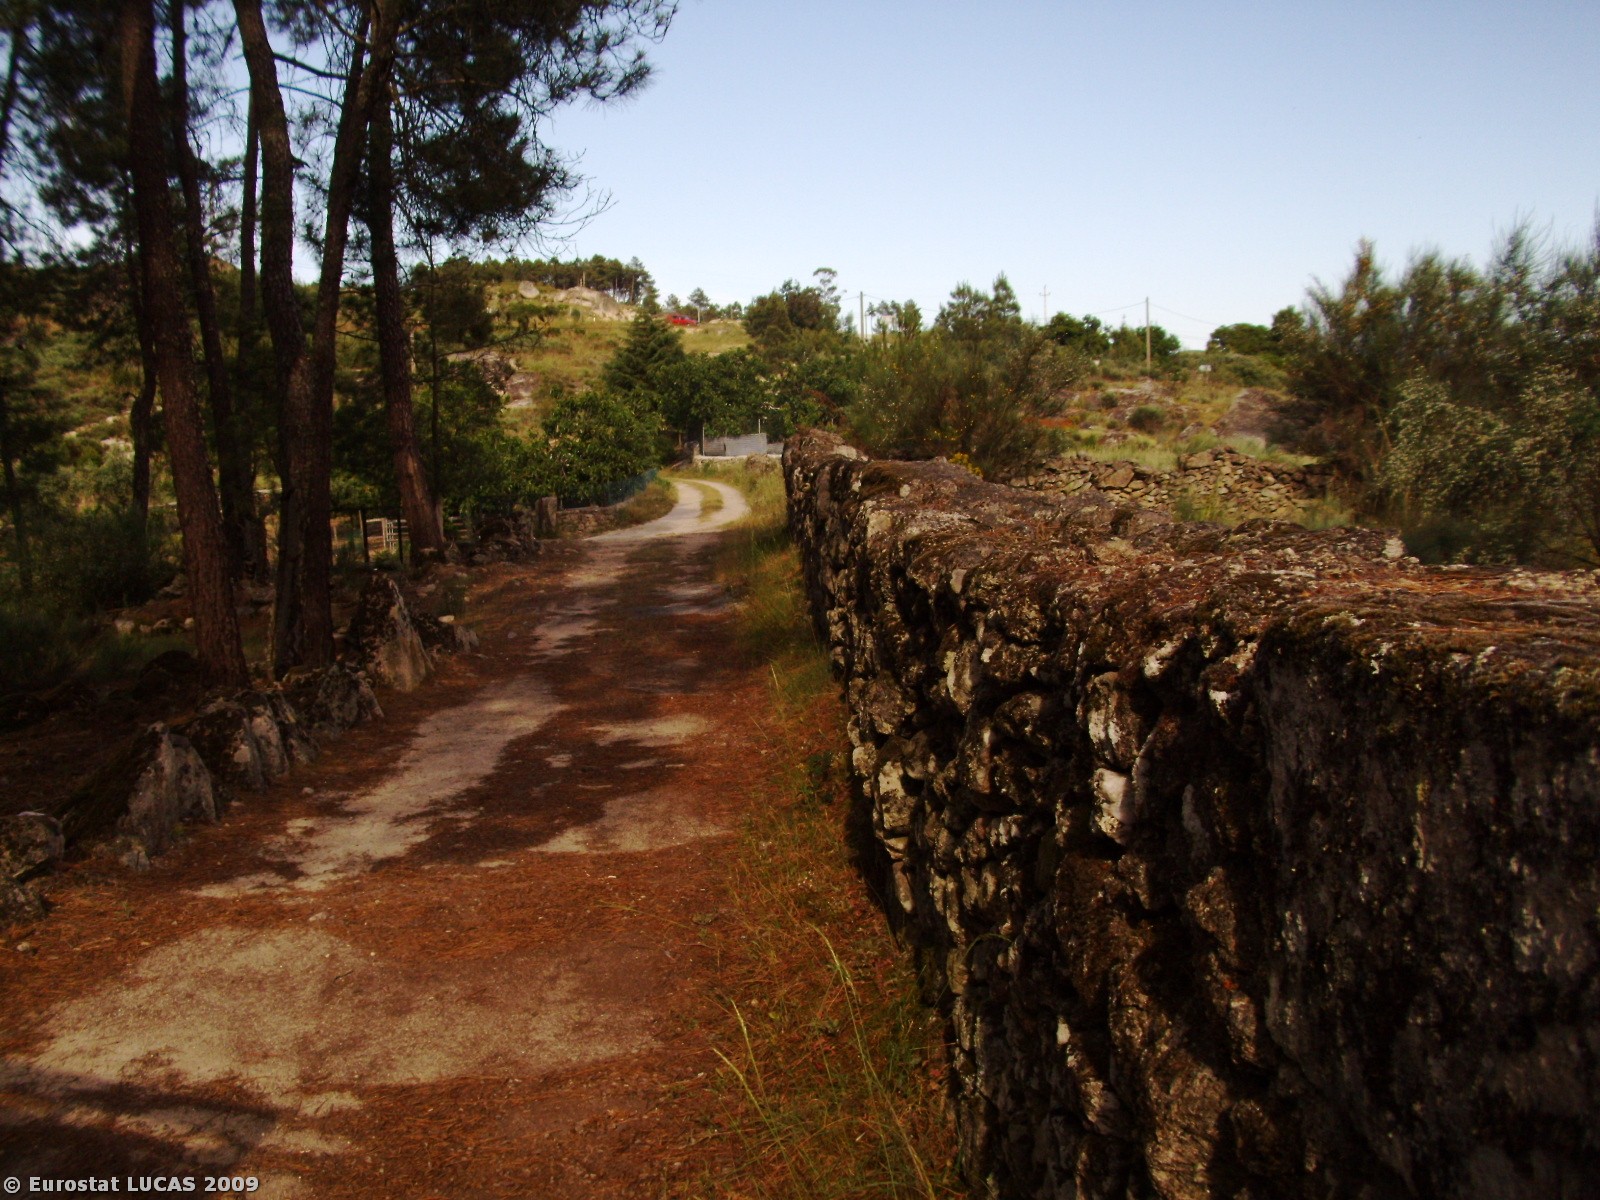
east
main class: Grassland
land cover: Spontaneously vegetated surfaces
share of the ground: > 75 %
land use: Fallow land
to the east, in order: Spontaneously vegetated surfaces; Olive groves; Fences; Spontaneously vegetated surfaces; Dry stone walls; Artificial constructions in urban areas; Paved roads, cycling and walking lanes; Dry stone walls; Spontaneously vegetated surfaces
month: May
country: PT
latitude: 40.6575
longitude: -7.4879
